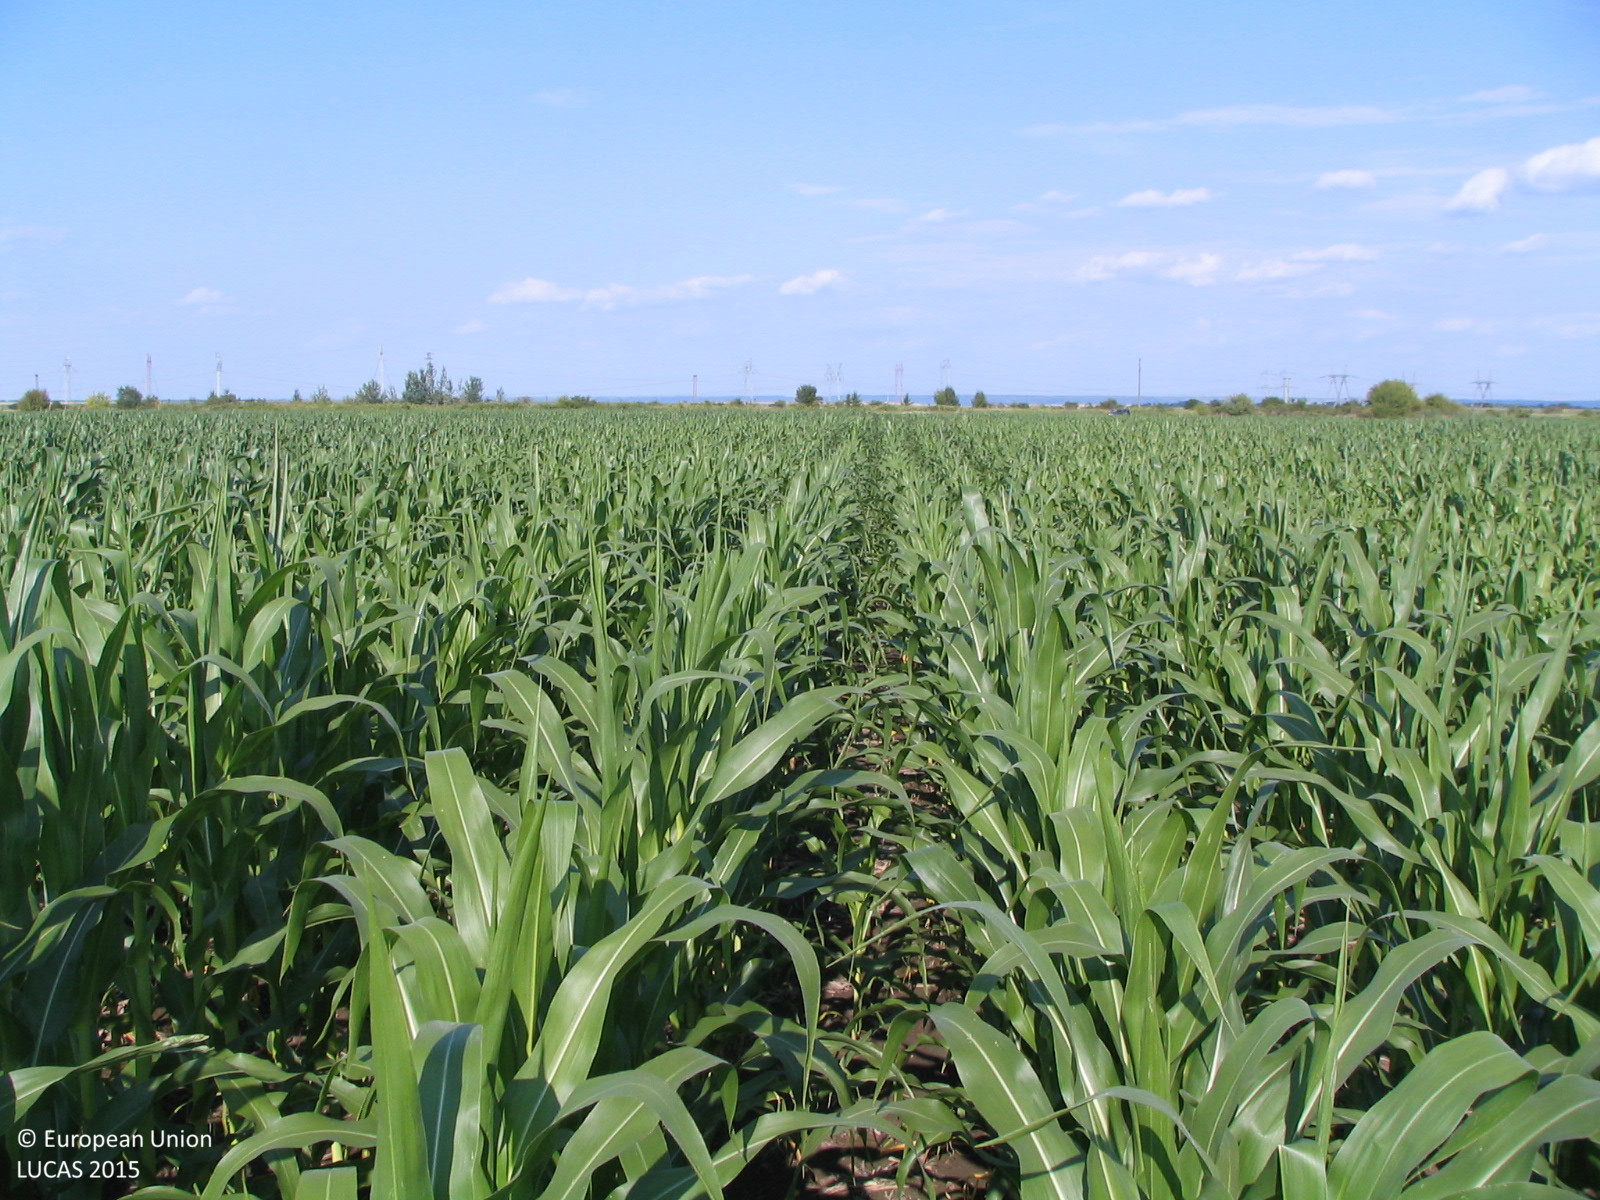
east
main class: Cropland
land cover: Maize
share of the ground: > 75 %
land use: Agriculture (excluding fallow land and kitchen gardens)
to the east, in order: Maize; Inland marshes
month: June
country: BG
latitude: 43.3762
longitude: 24.0109
